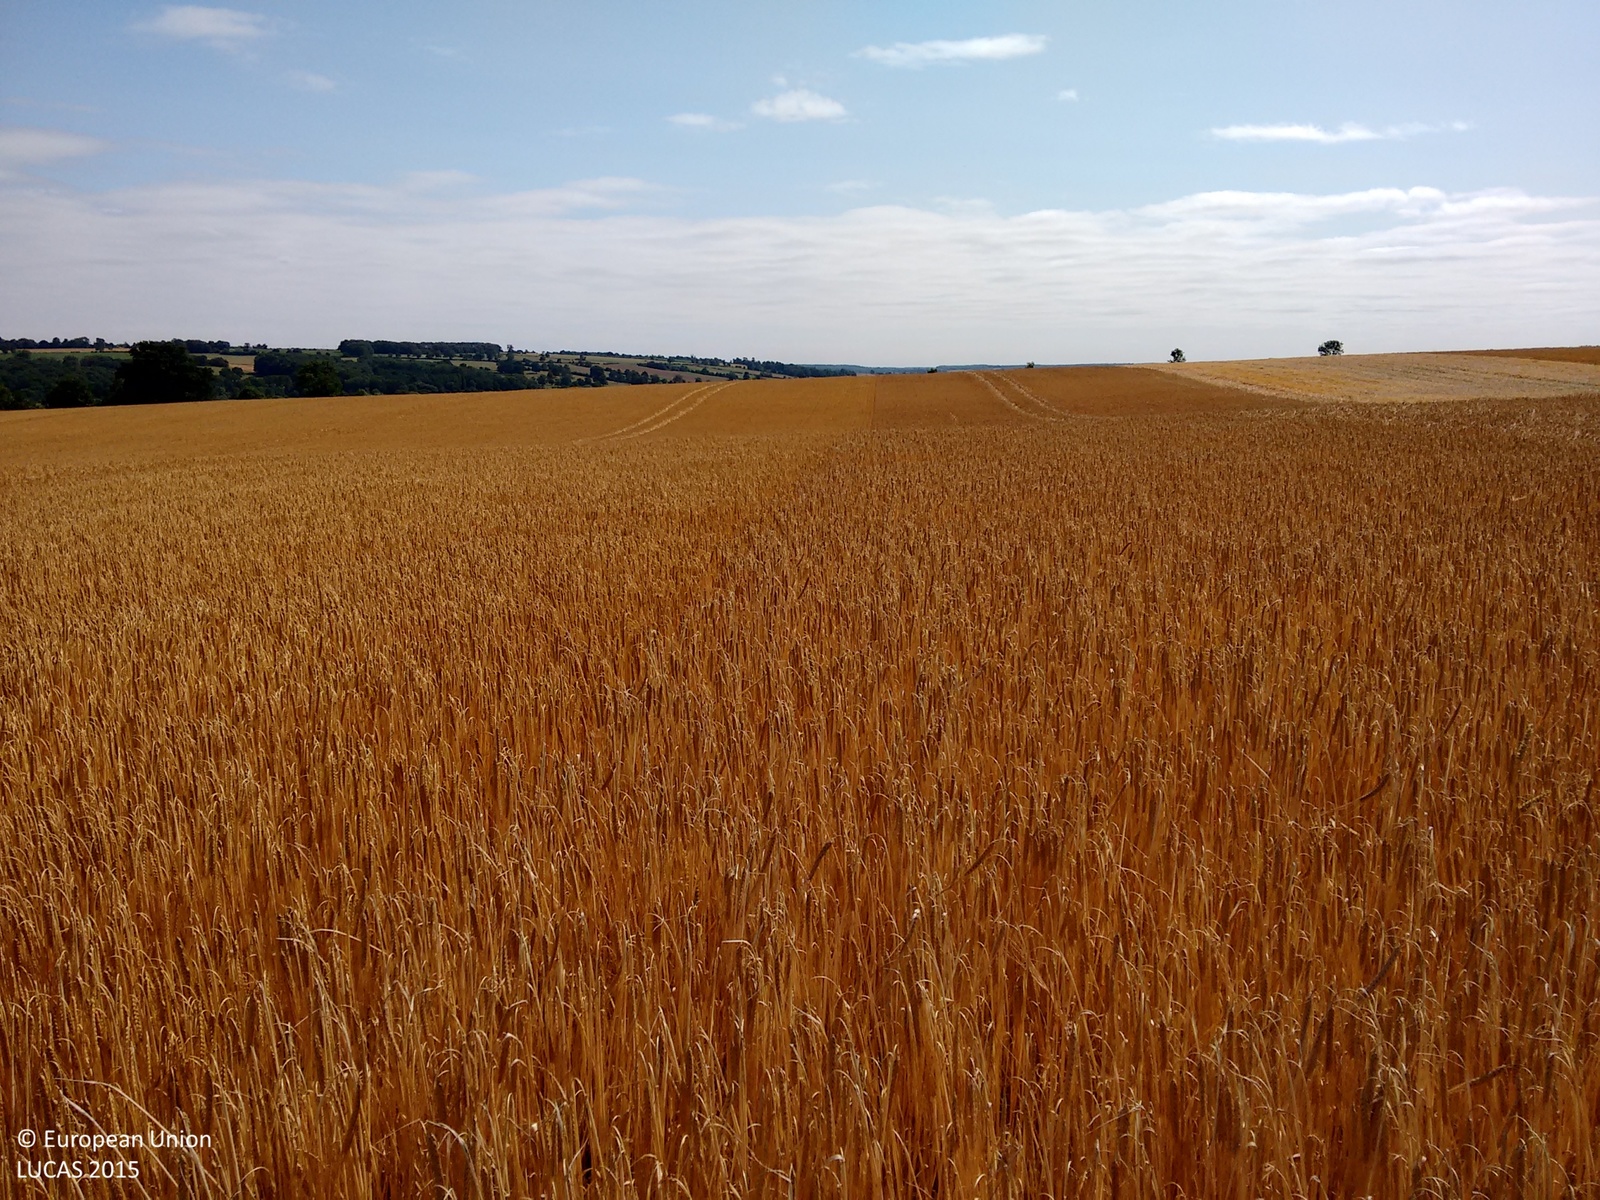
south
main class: Cropland
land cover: Barley
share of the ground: > 75 %
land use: Agriculture (excluding fallow land and kitchen gardens)
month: July
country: GB
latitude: 52.6523
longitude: -0.5186
